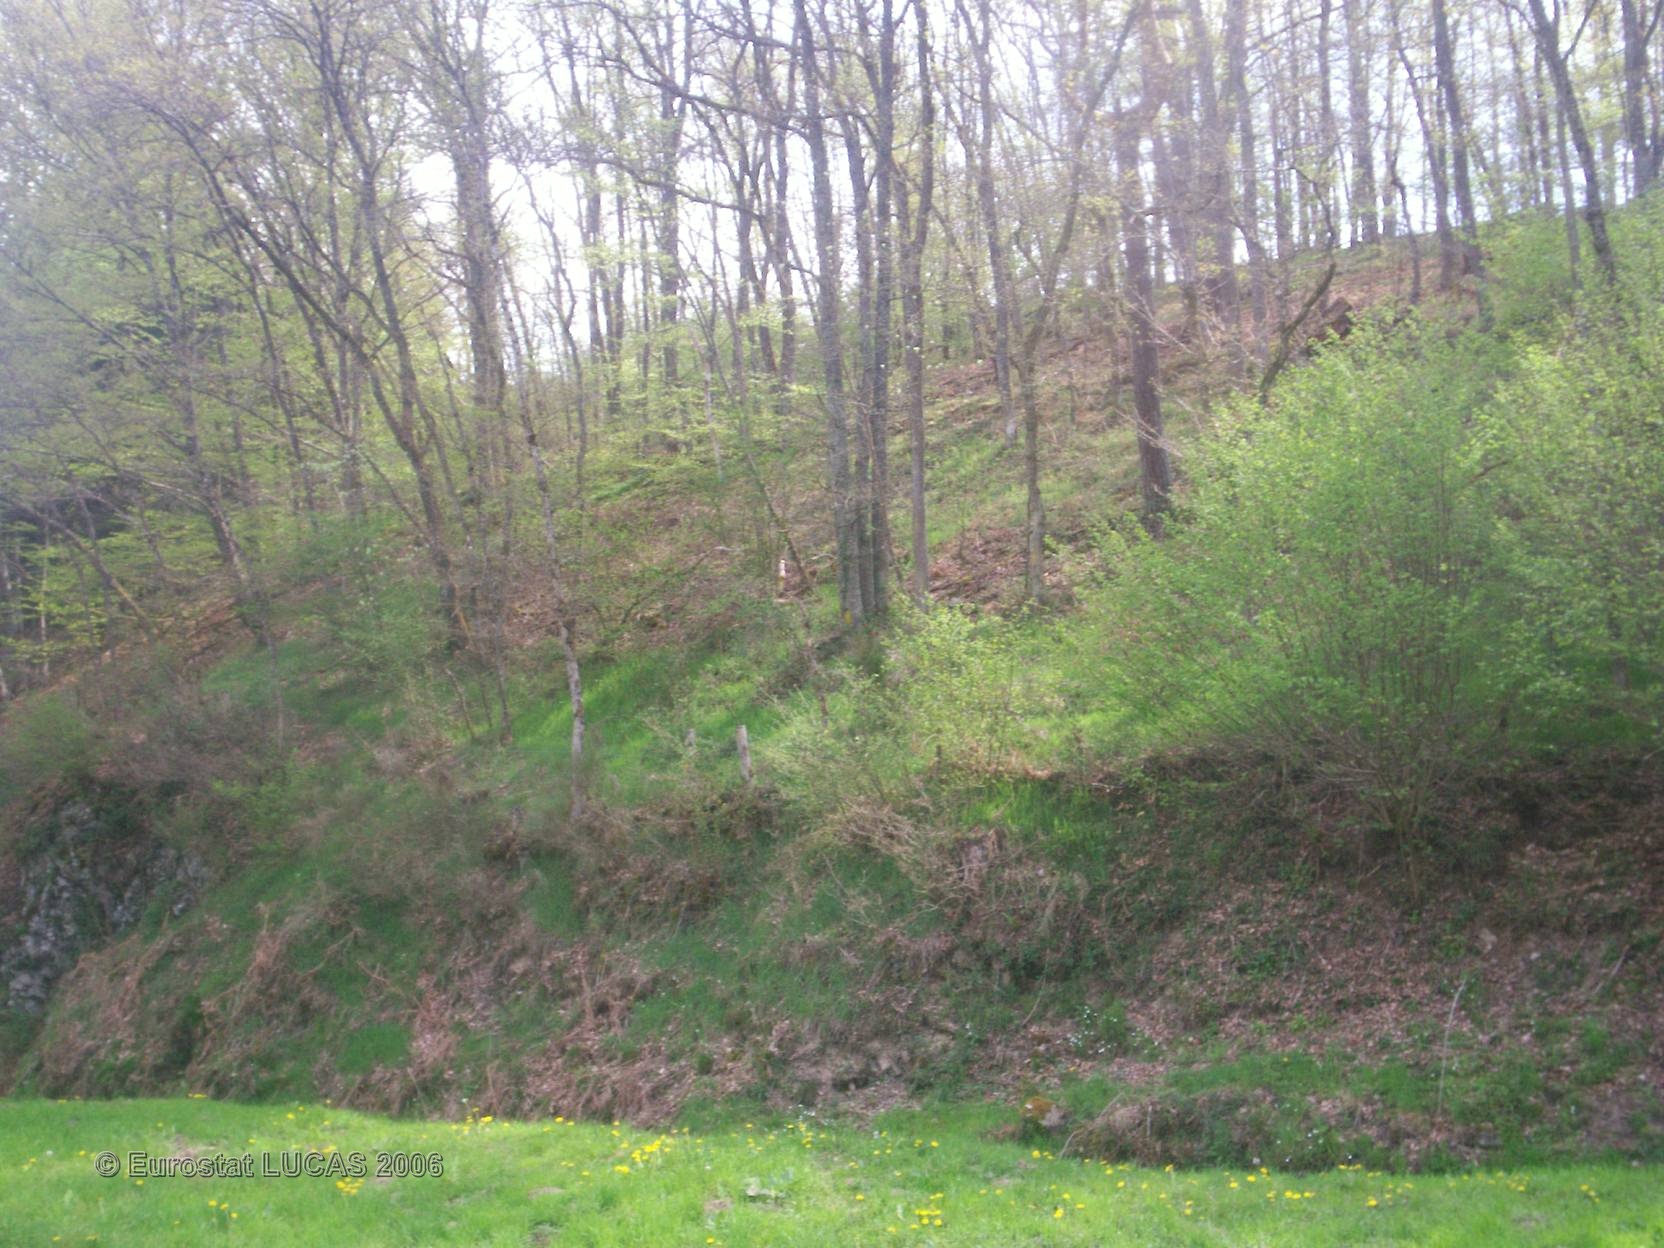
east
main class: Grassland
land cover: Grassland without tree/shrub cover
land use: Agriculture (excluding fallow land and kitchen gardens)
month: May
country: FR
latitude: 46.0072
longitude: 2.9085
